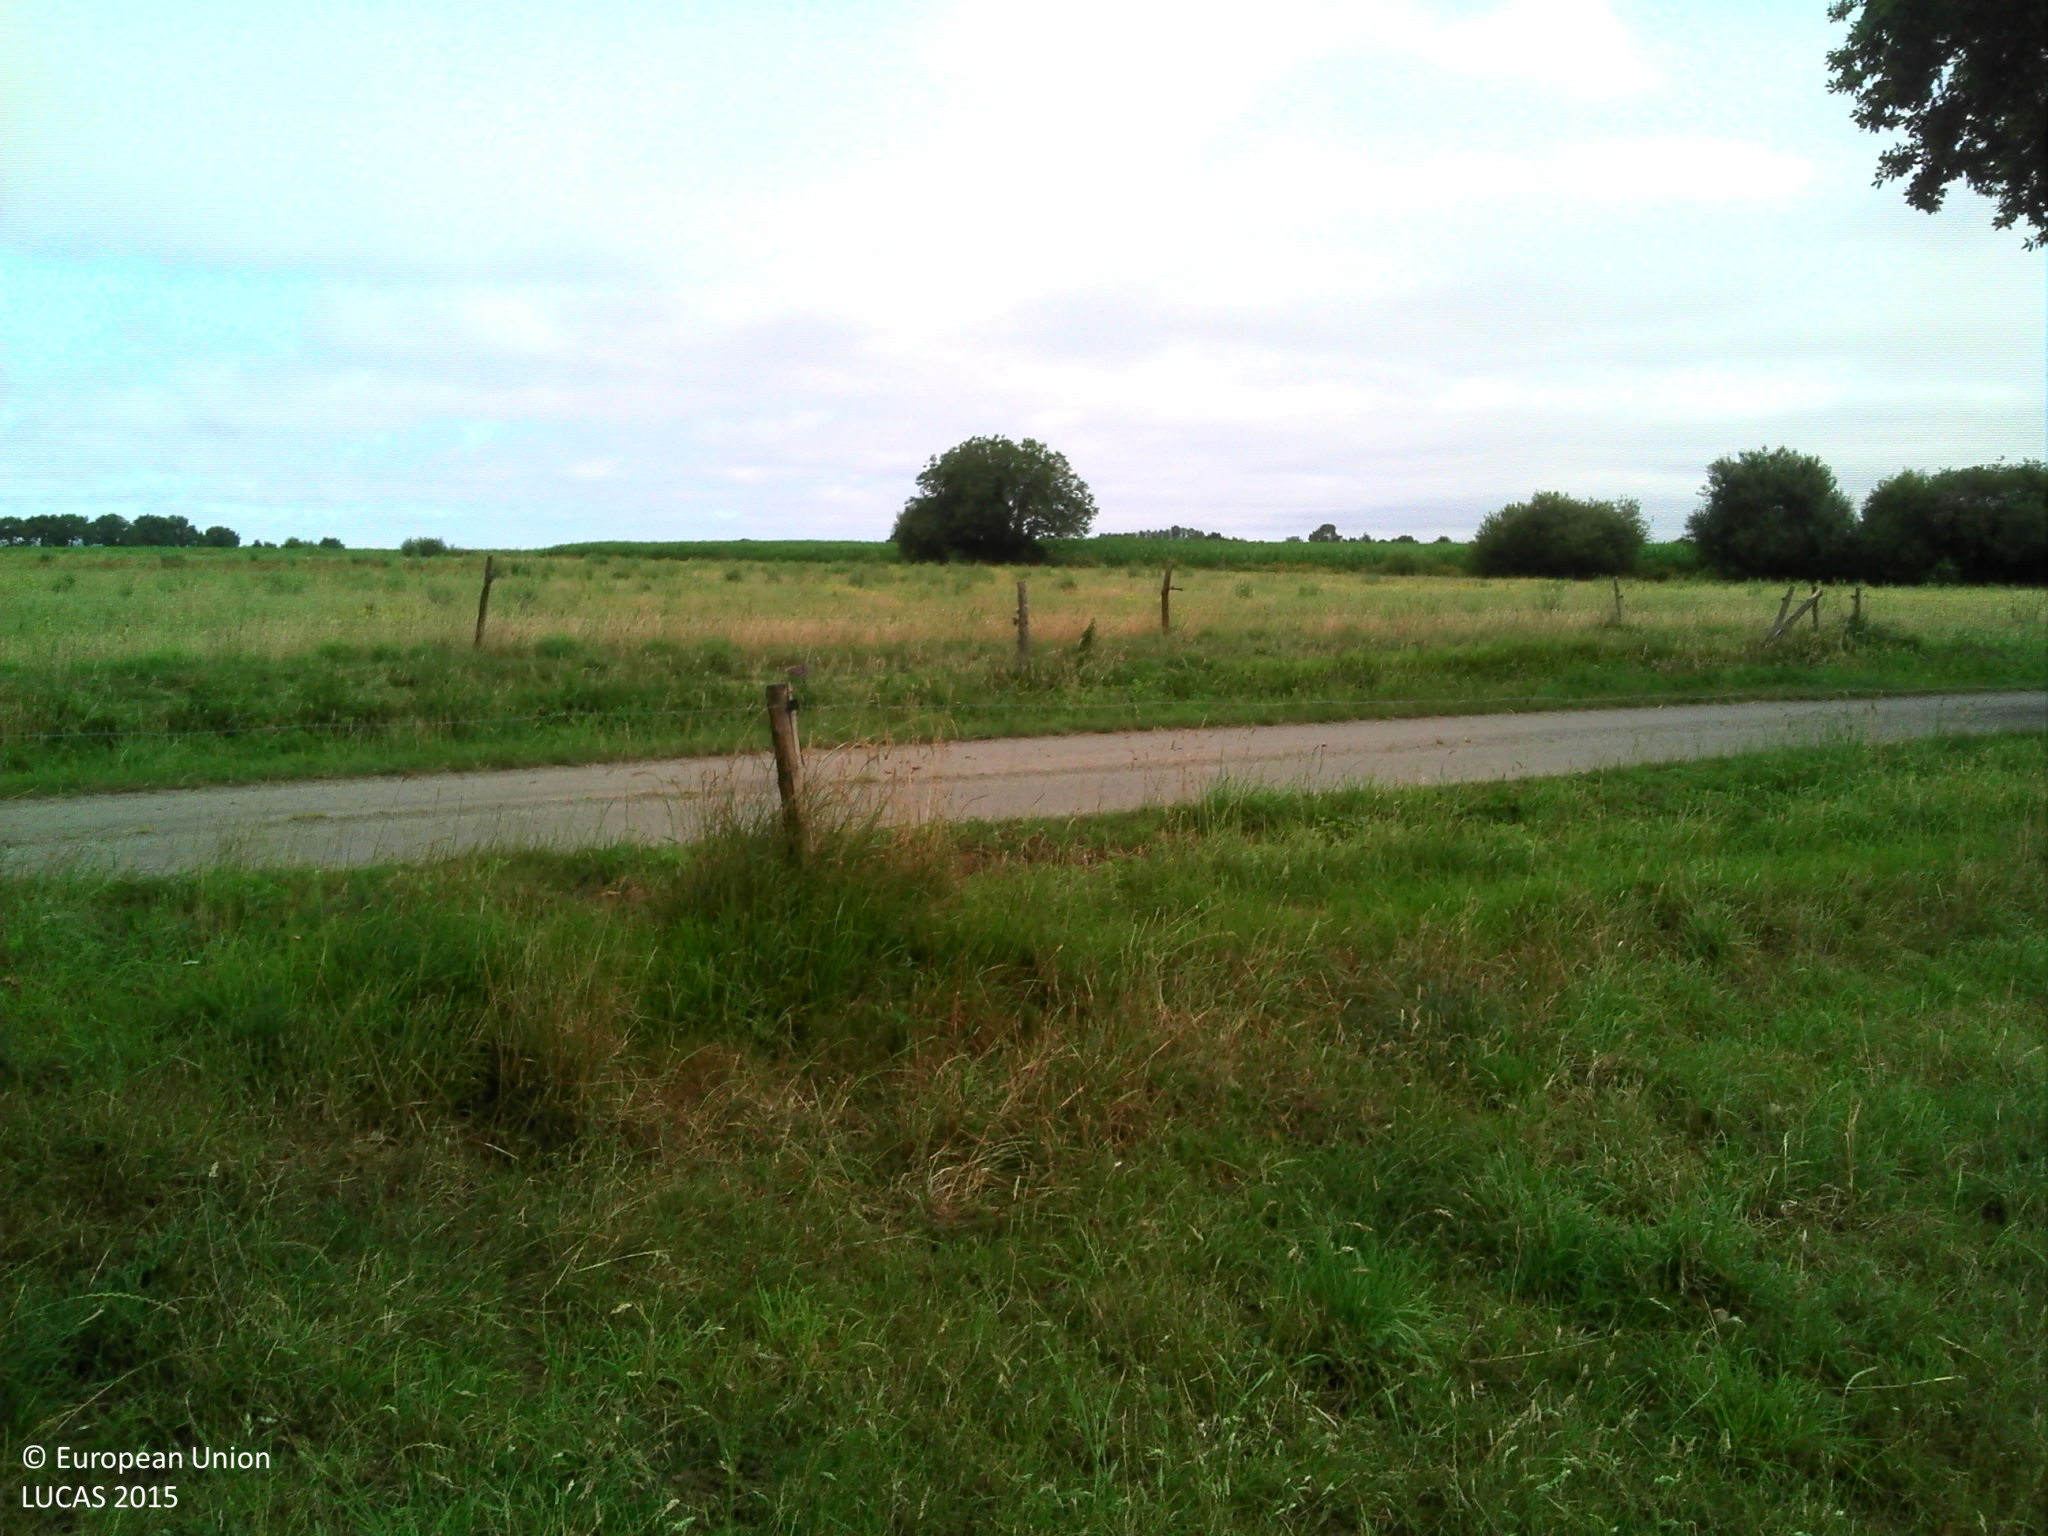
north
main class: Cropland
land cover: Temporary grasslands
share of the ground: > 75 %
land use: Agriculture (excluding fallow land and kitchen gardens)
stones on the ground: 10 - 25 %
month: July
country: FR
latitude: 47.6154
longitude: -1.8759
